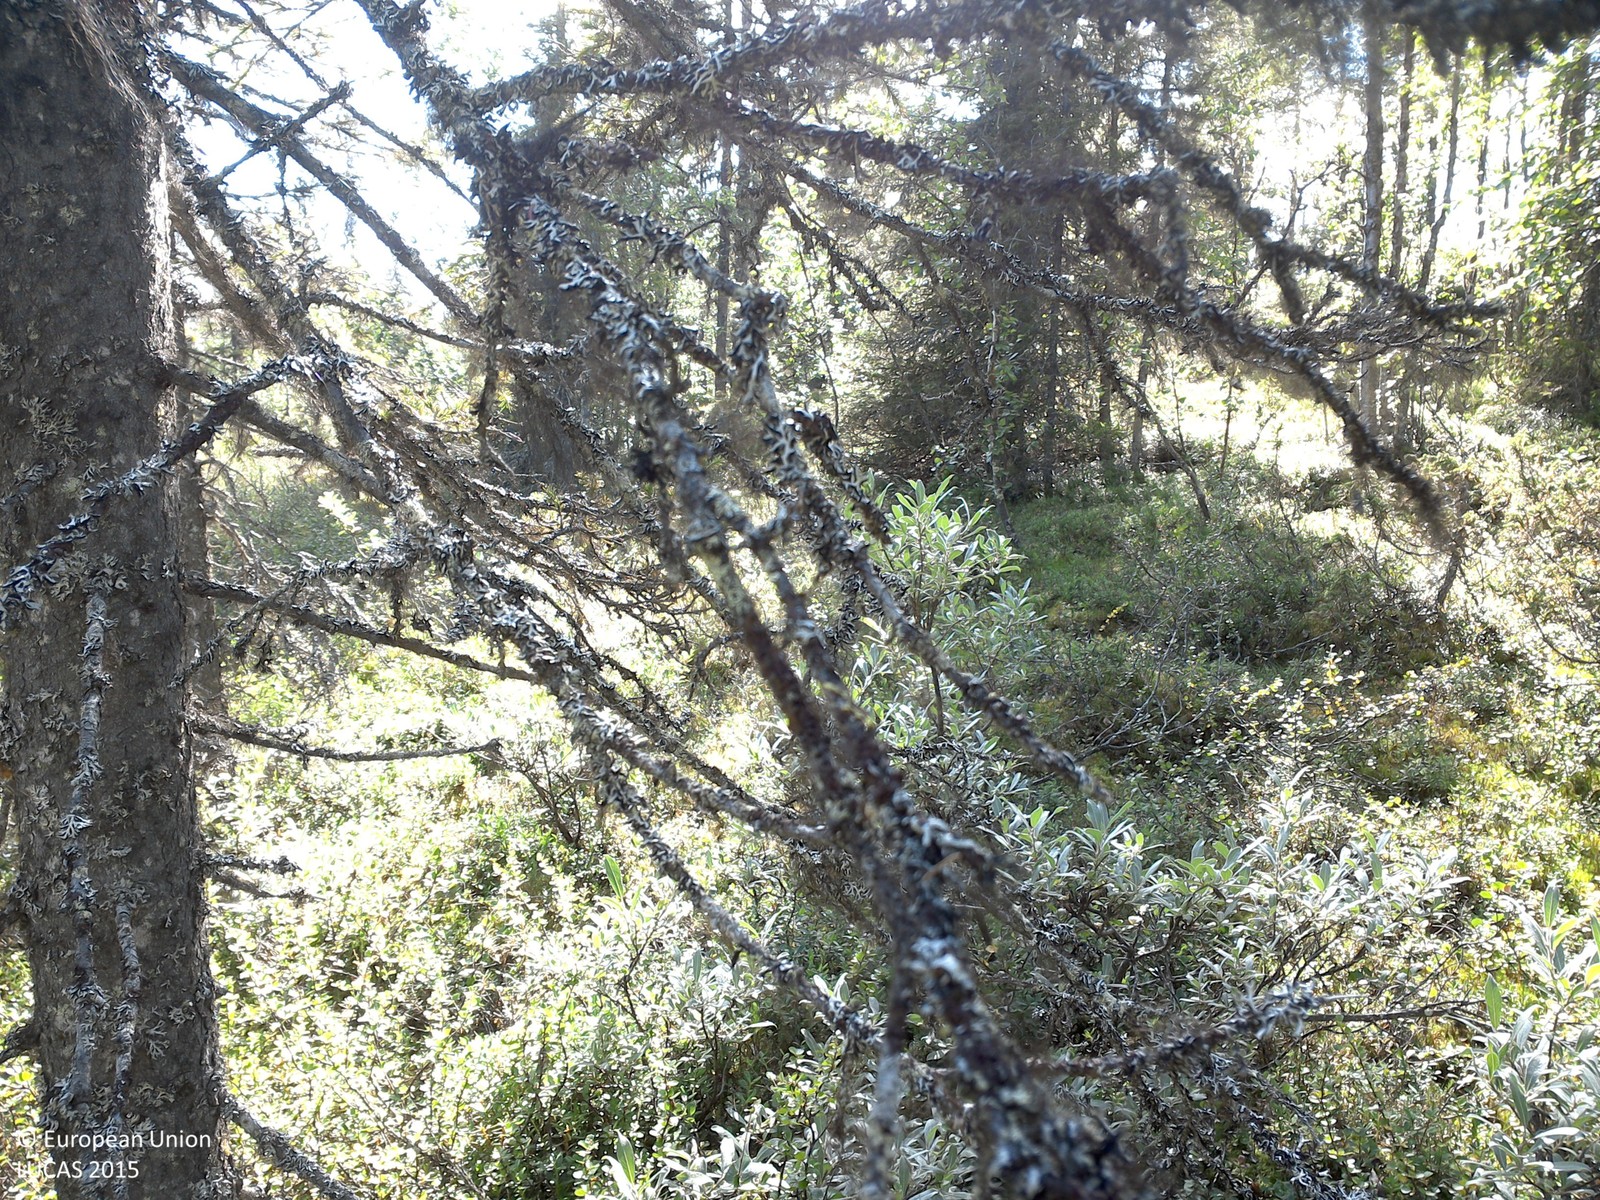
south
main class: Woodland
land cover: Pine dominated mixed woodland
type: boreal forest
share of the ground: 25 - 50 %
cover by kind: shrubs 70 %, coniferous forest trees 15 %, broadleaved forest trees 10 %, lichens and mosses 5 %
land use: Forestry
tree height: > 5 m
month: August
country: SE
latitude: 67.4227
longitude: 21.2223
